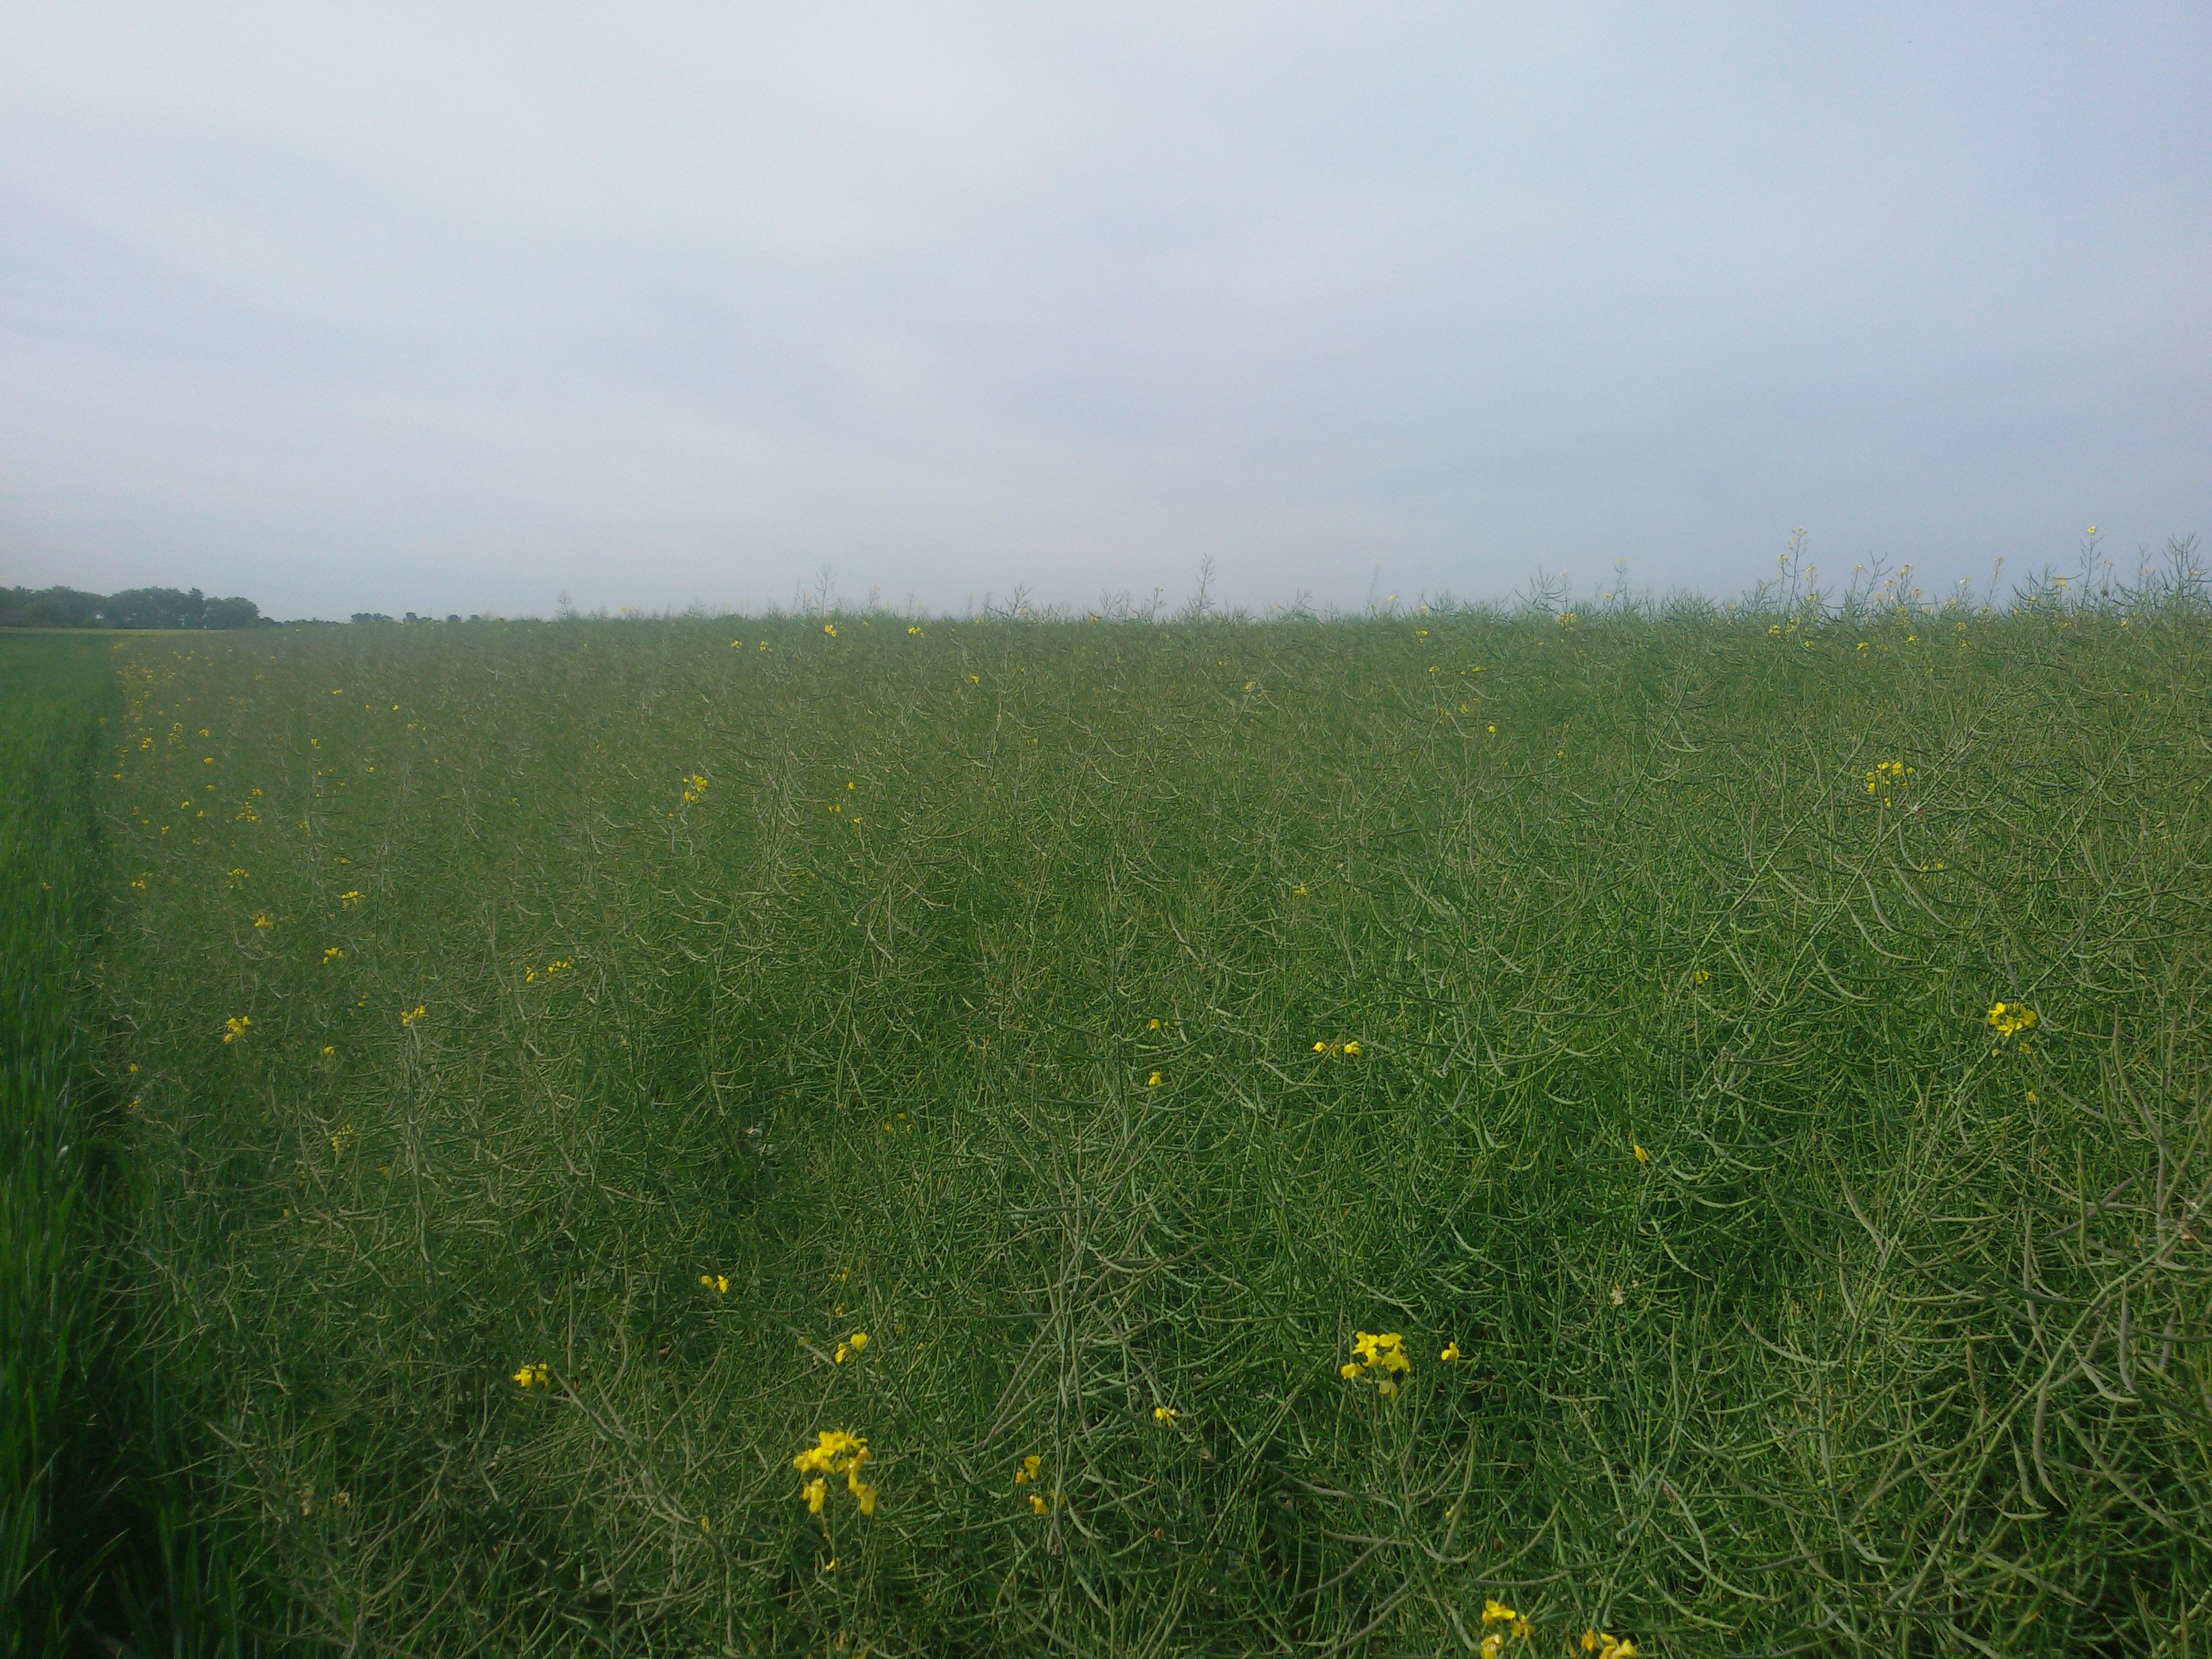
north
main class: Cropland
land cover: Rape and turnip rape
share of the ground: > 75 %
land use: Agriculture (excluding fallow land and kitchen gardens)
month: May
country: PL
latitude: 50.3448
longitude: 17.6155
